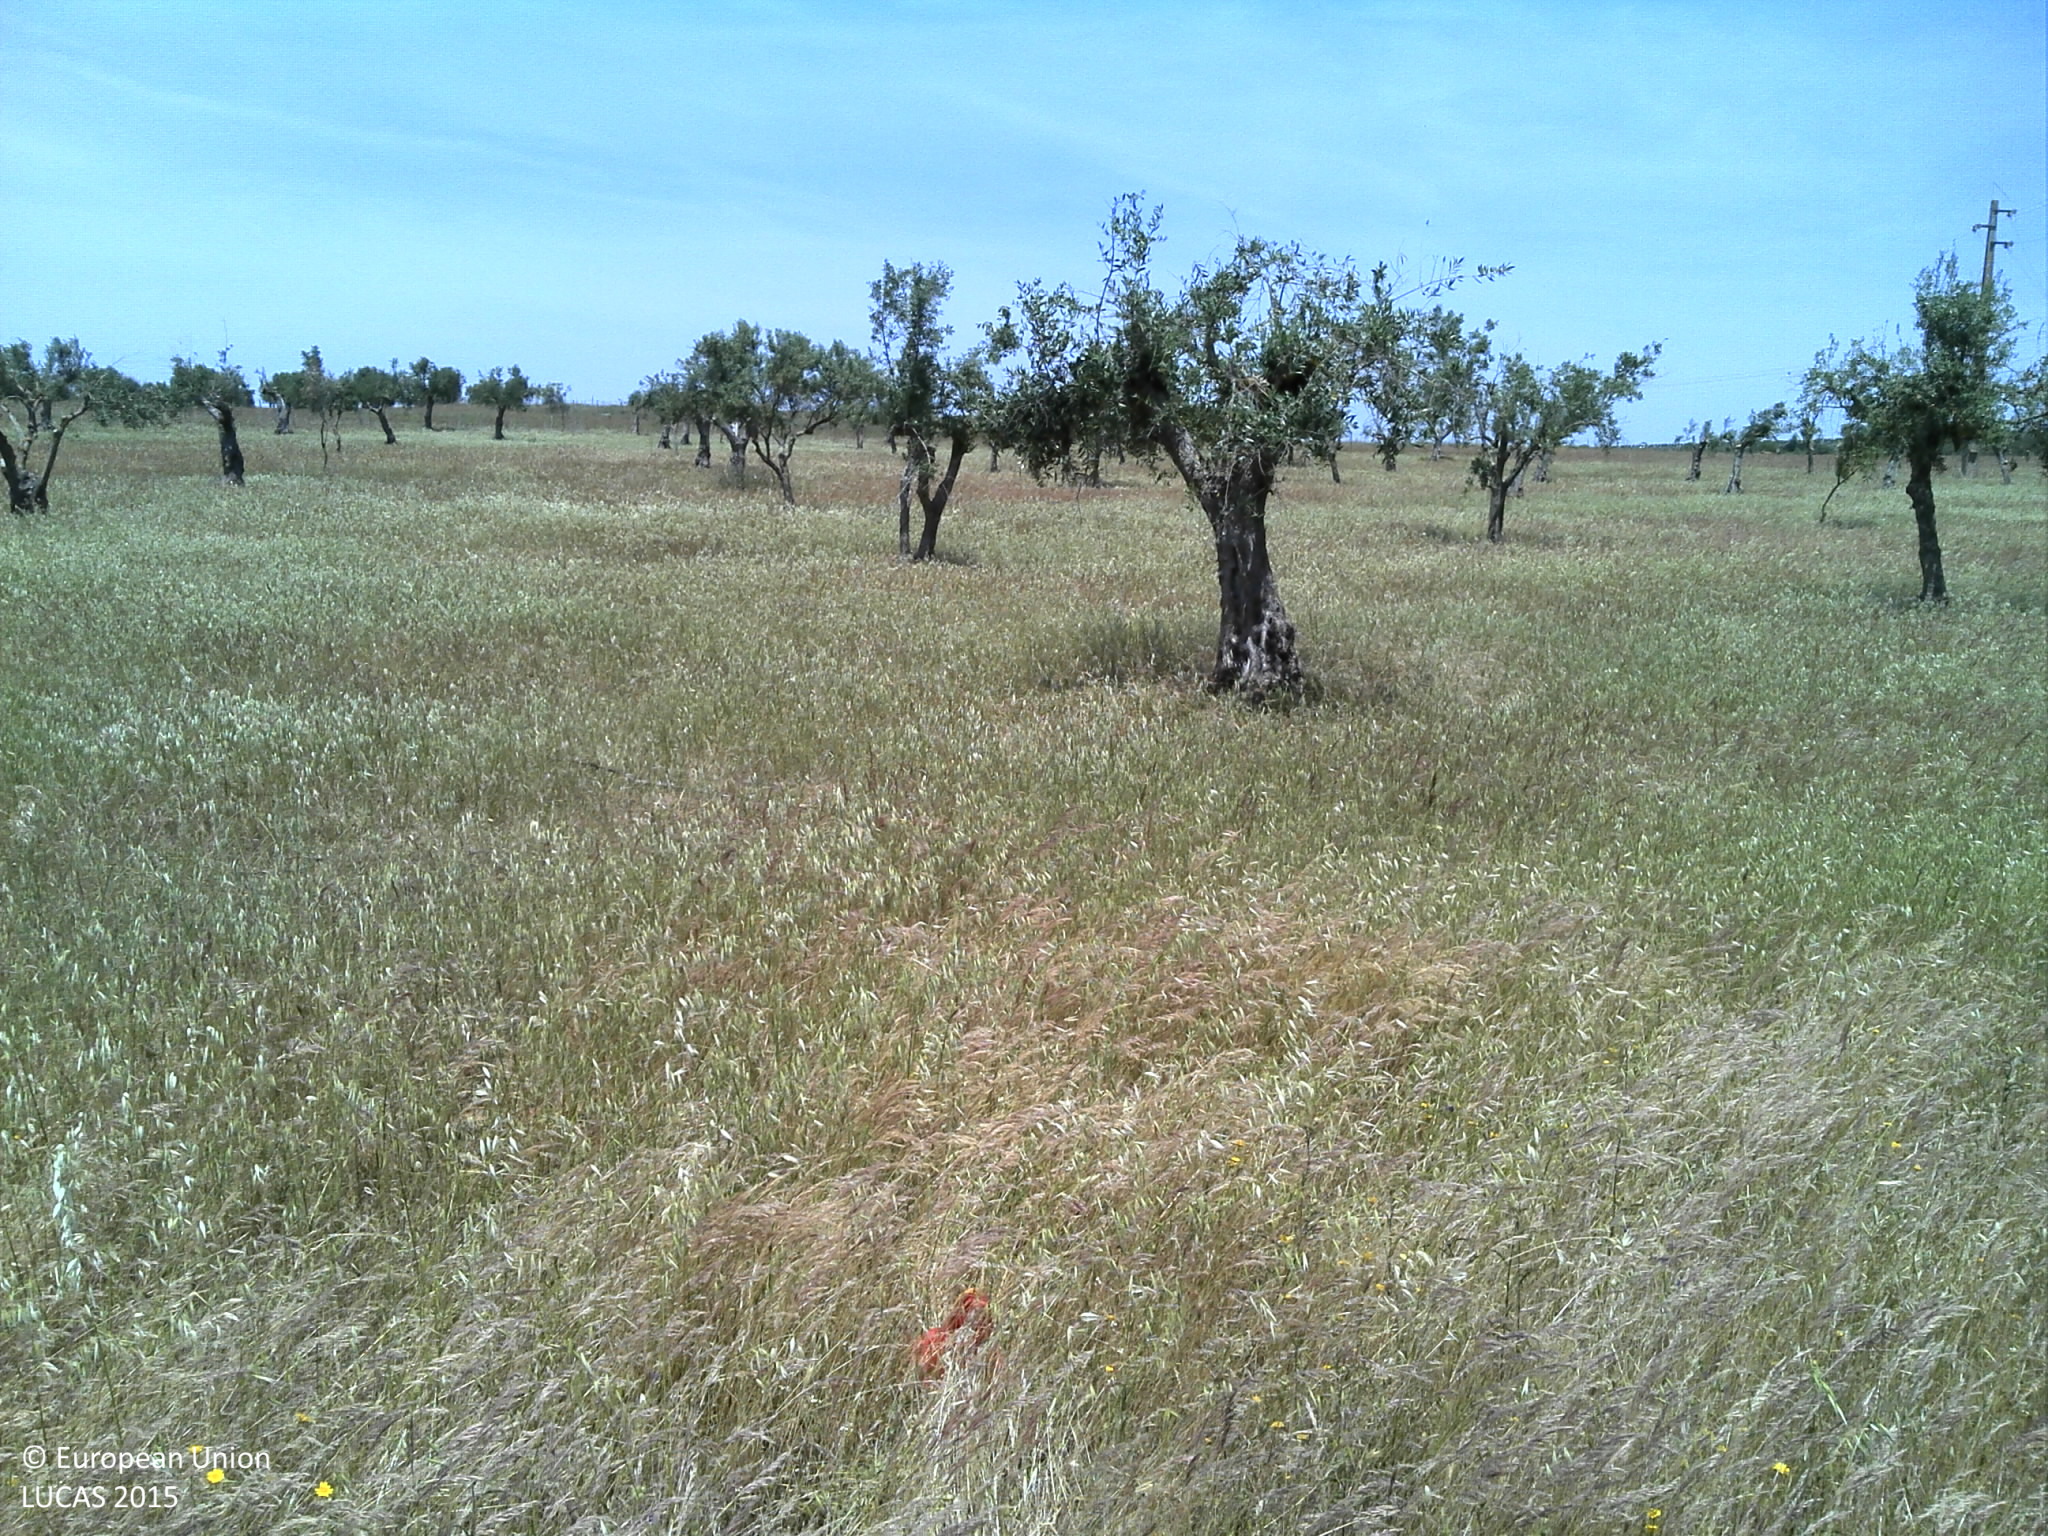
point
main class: Cropland
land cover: Olive groves
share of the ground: 10 - 25 %
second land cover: Grassland without tree/shrub cover
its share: 25 - 50 %
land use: Agriculture (excluding fallow land and kitchen gardens)
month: May
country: PT
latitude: 39.1877
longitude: -7.6540
